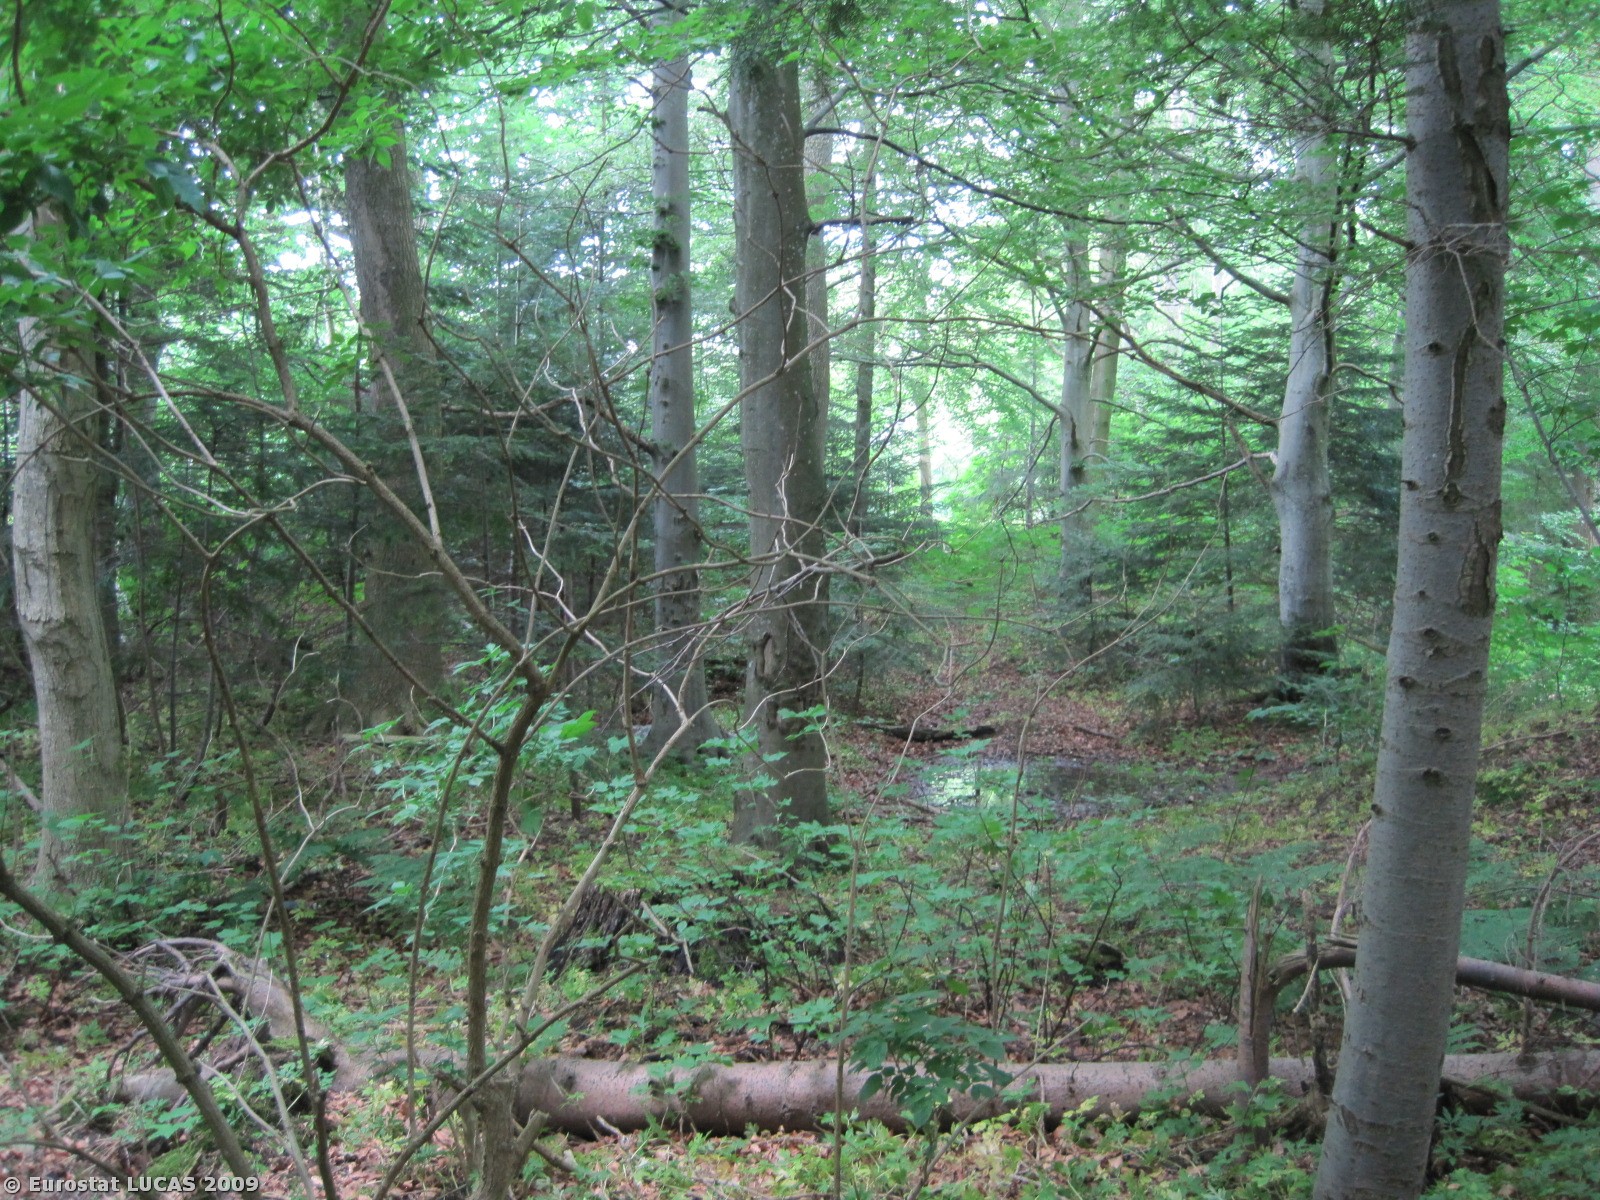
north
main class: Woodland
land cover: Mixed woodland
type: plantations and self-sown exotic forest
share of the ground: > 75 %
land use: Amenities, museums, leisure
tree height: > 5 m
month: June
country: DK
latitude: 57.1582
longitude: 10.2806
